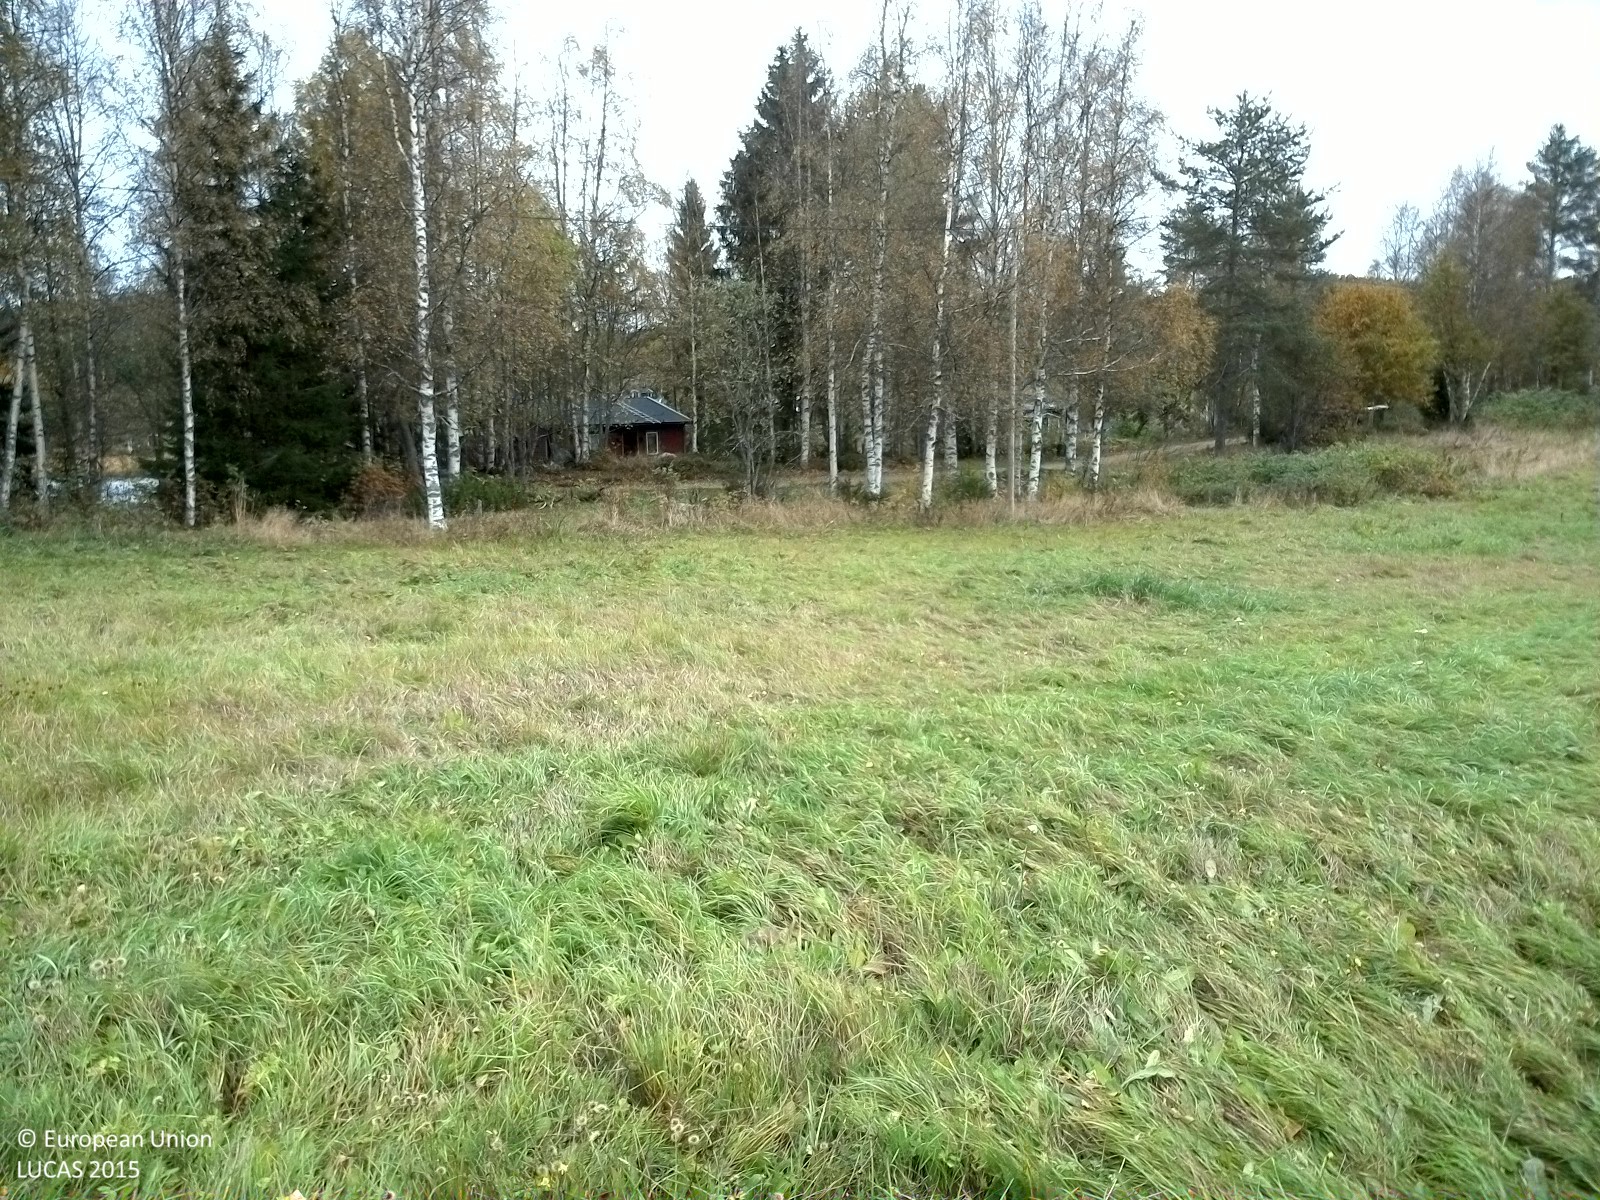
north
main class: Grassland
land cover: Grassland without tree/shrub cover
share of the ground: > 75 %
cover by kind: herbaceous plants 100 %
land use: Amenities, museums, leisure
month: October
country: SE
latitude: 62.6297
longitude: 17.7593
